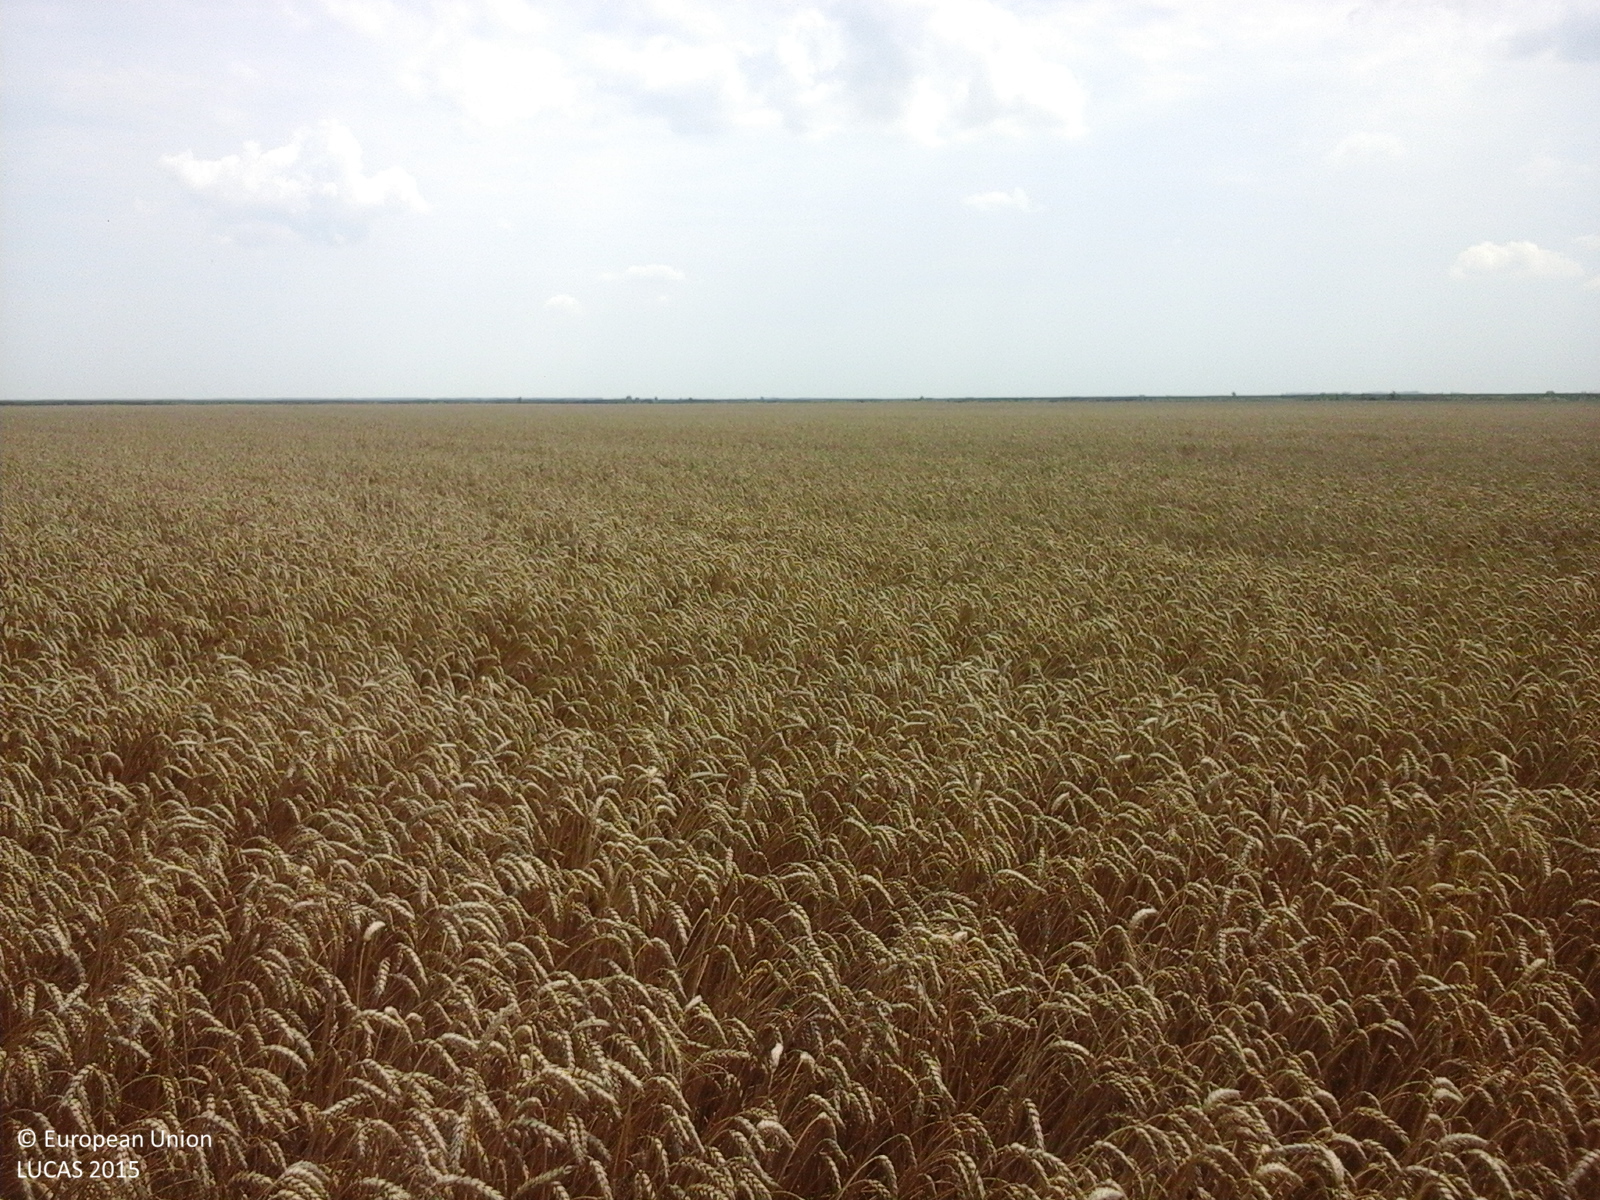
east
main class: Cropland
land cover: Common wheat
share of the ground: > 75 %
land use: Agriculture (excluding fallow land and kitchen gardens)
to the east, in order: Common wheat
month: July
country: RO
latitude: 44.0219
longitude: 25.4941
